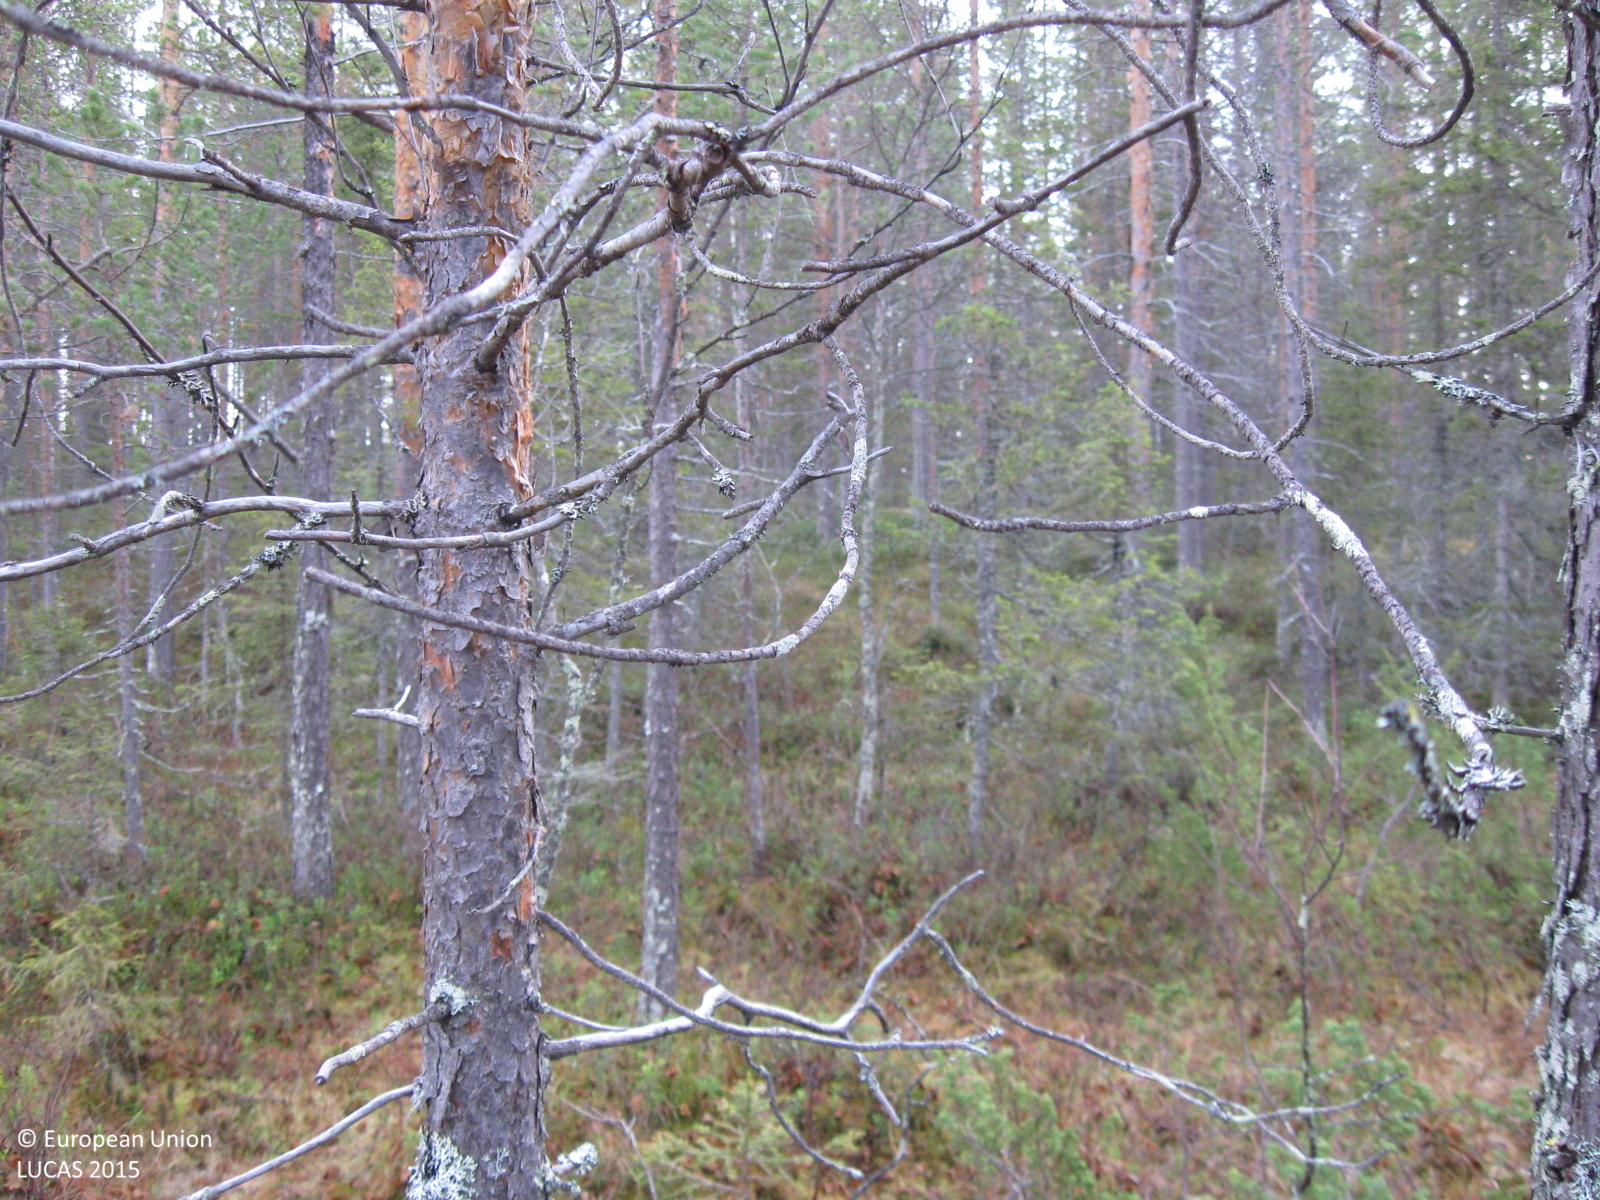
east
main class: Woodland
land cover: Pine dominated coniferous woodland
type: mire and swamp forests
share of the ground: 50 - 75 %
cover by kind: coniferous forest trees 60 %, shrubs 15 %, broadleaved forest trees 10 %, lichens and mosses 10 %, herbaceous plants 5 %
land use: Forestry
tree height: > 5 m
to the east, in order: Pine dominated coniferous woodland; Peatbogs; Pine dominated coniferous woodland
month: November
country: SE
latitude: 66.0175
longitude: 20.5672
